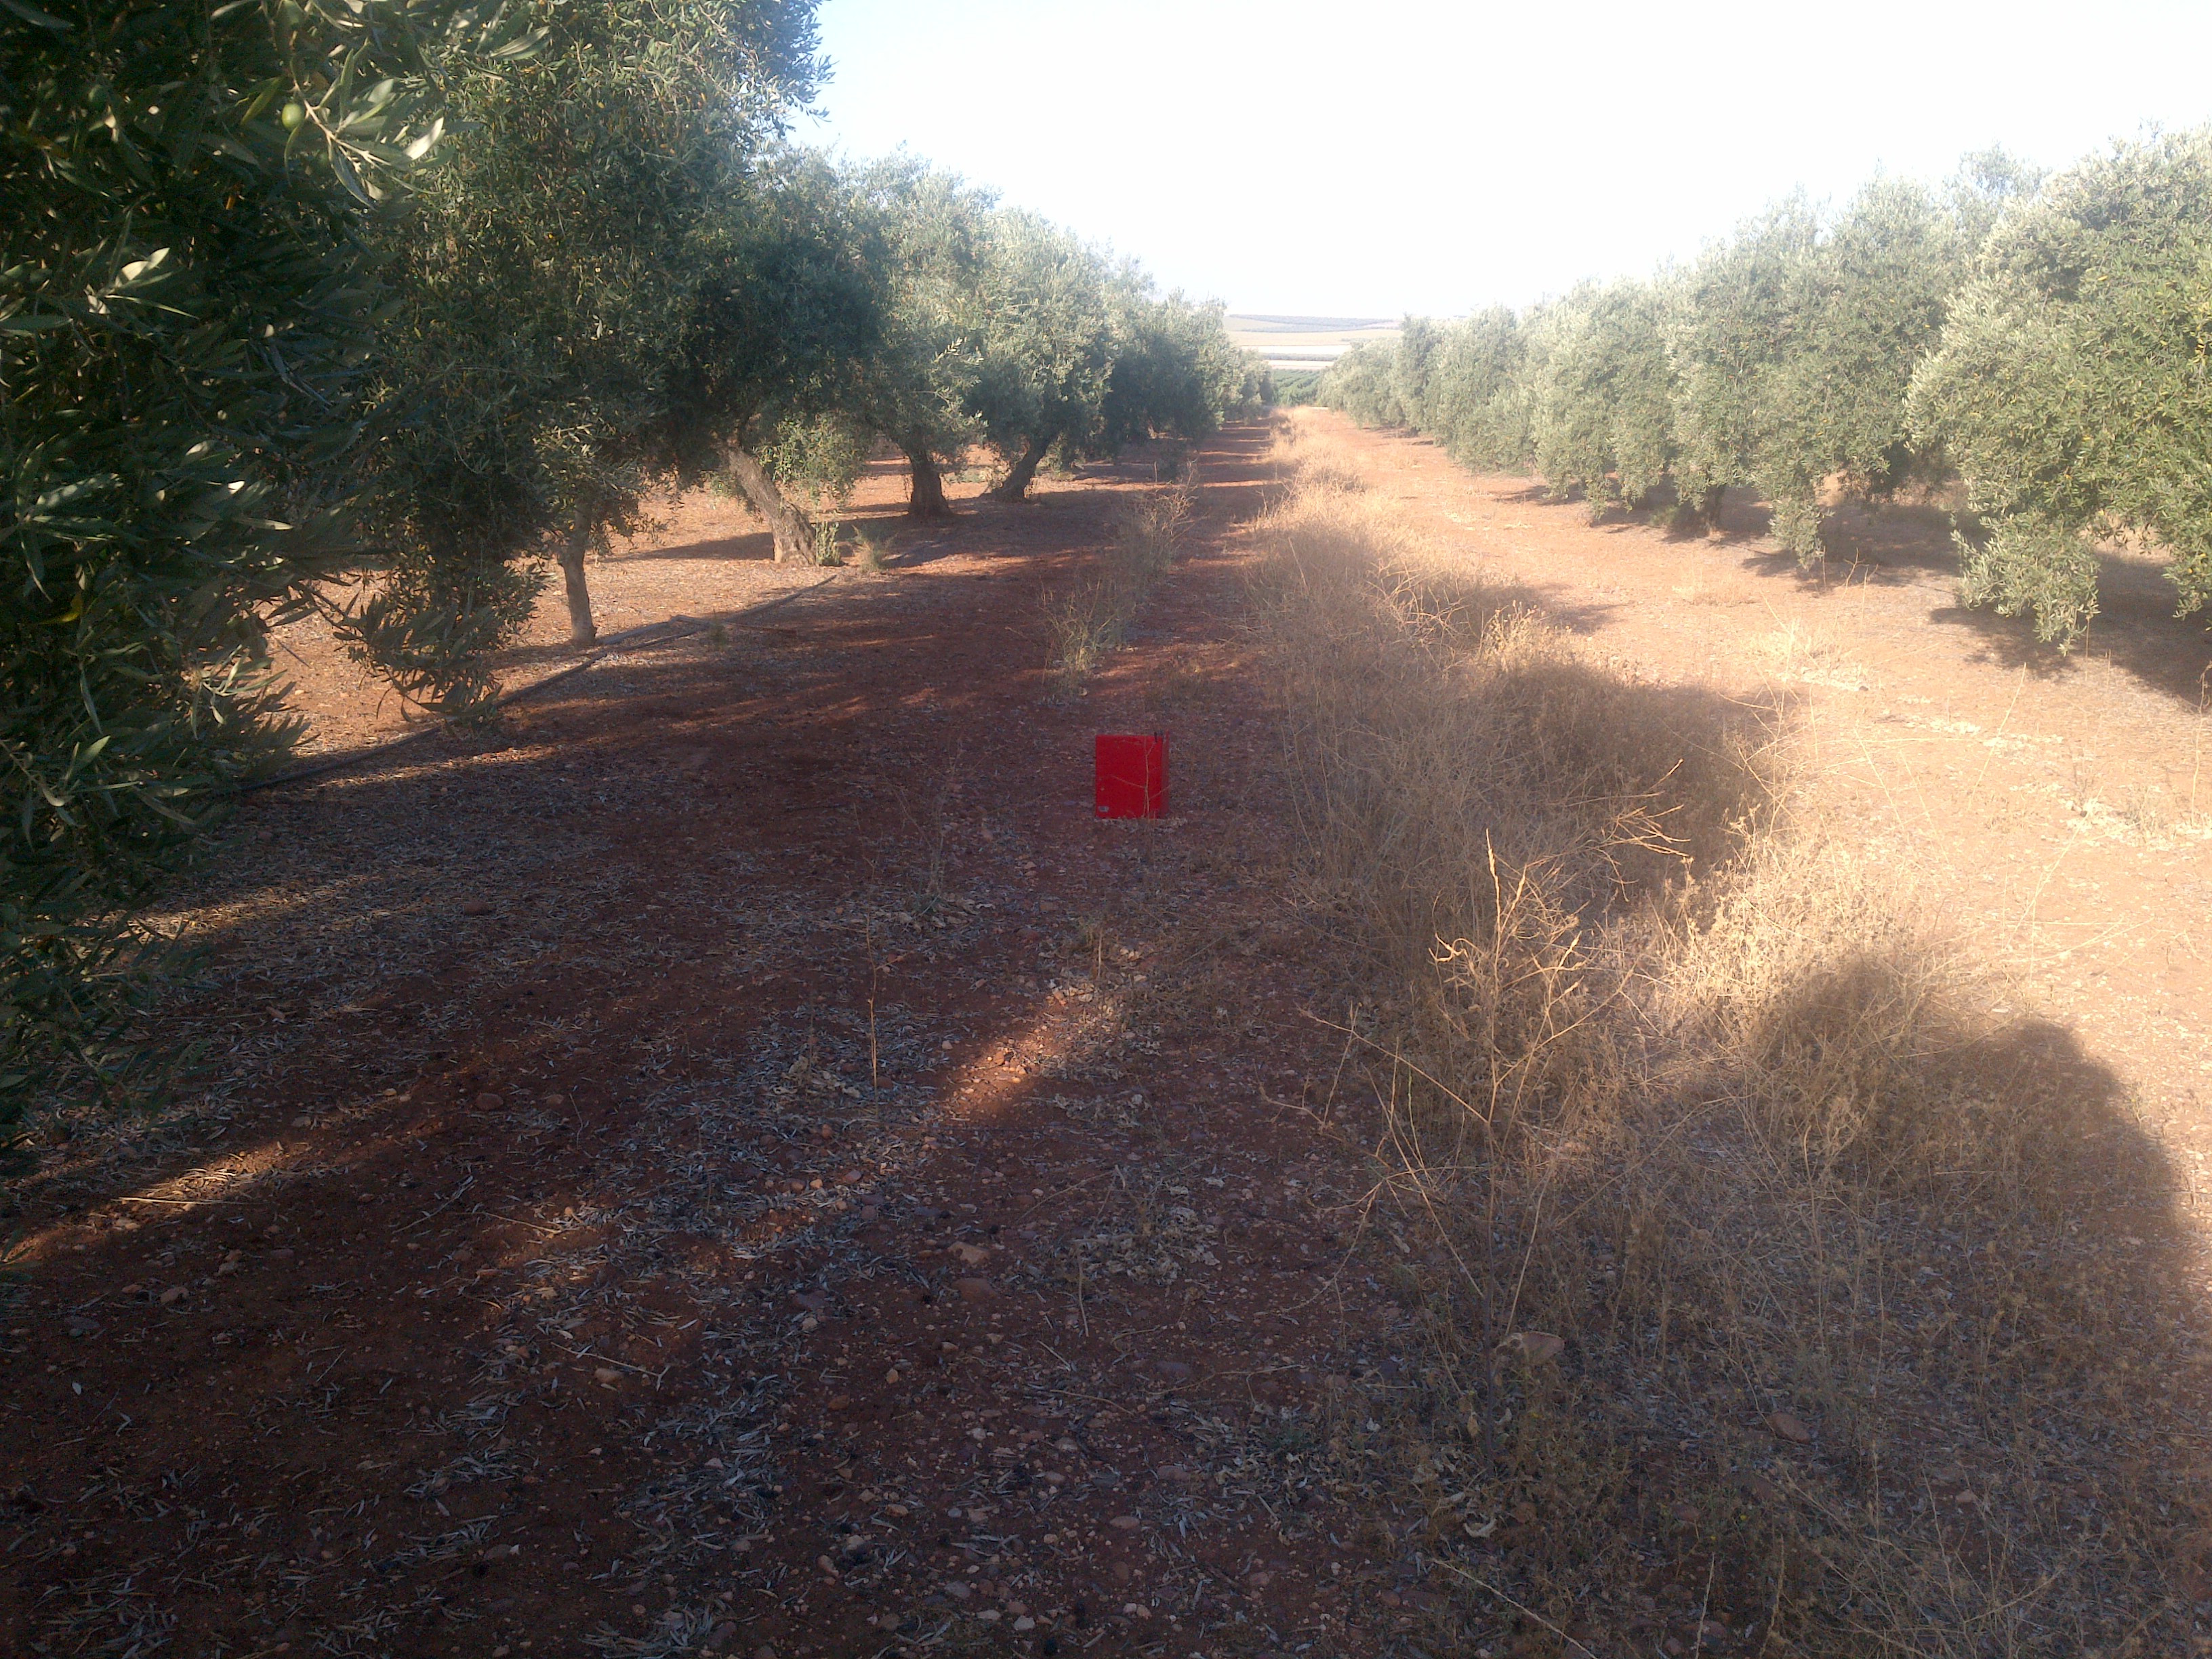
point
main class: Cropland
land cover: Olive groves
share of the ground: 50 - 75 %
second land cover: Spontaneously vegetated surfaces
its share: 10 - 25 %
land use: Agriculture (excluding fallow land and kitchen gardens)
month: June
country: ES
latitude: 37.6317
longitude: -4.9128
